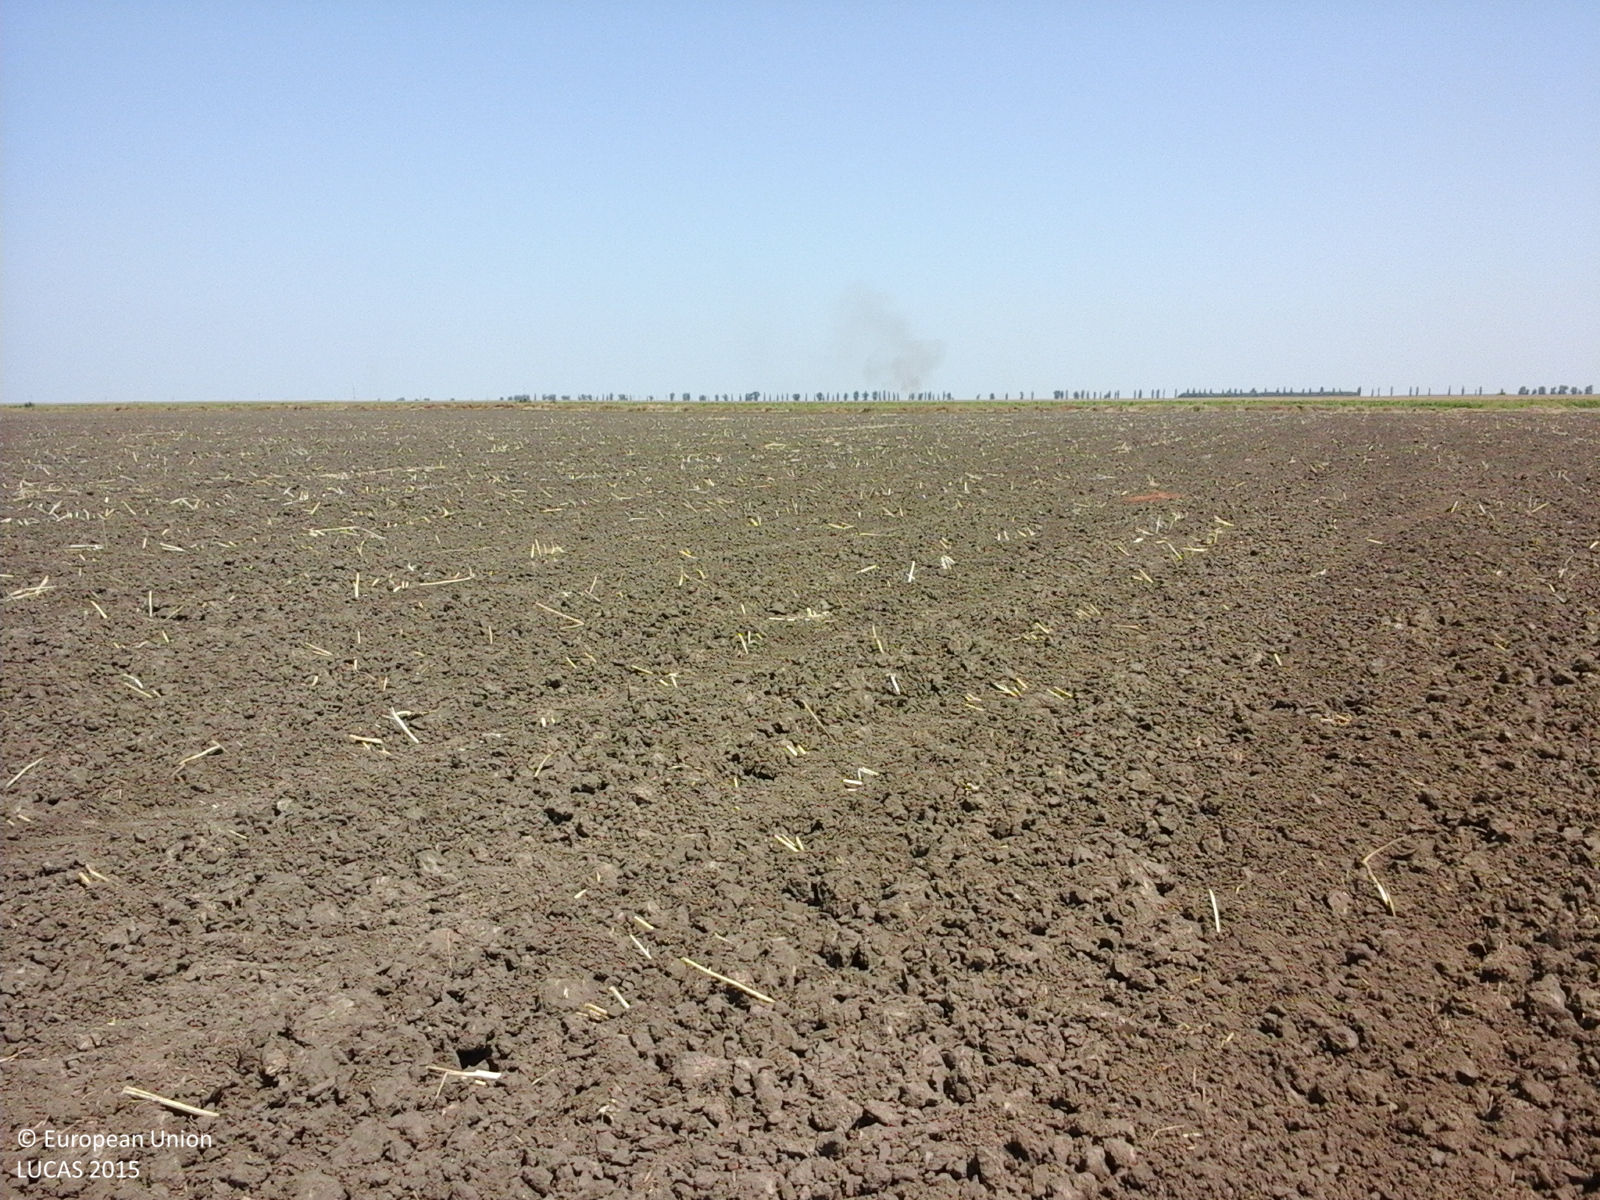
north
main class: Cropland
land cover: Rape and turnip rape
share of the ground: < 10 %
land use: Agriculture (excluding fallow land and kitchen gardens)
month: July
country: RO
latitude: 44.2965
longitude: 27.1125
